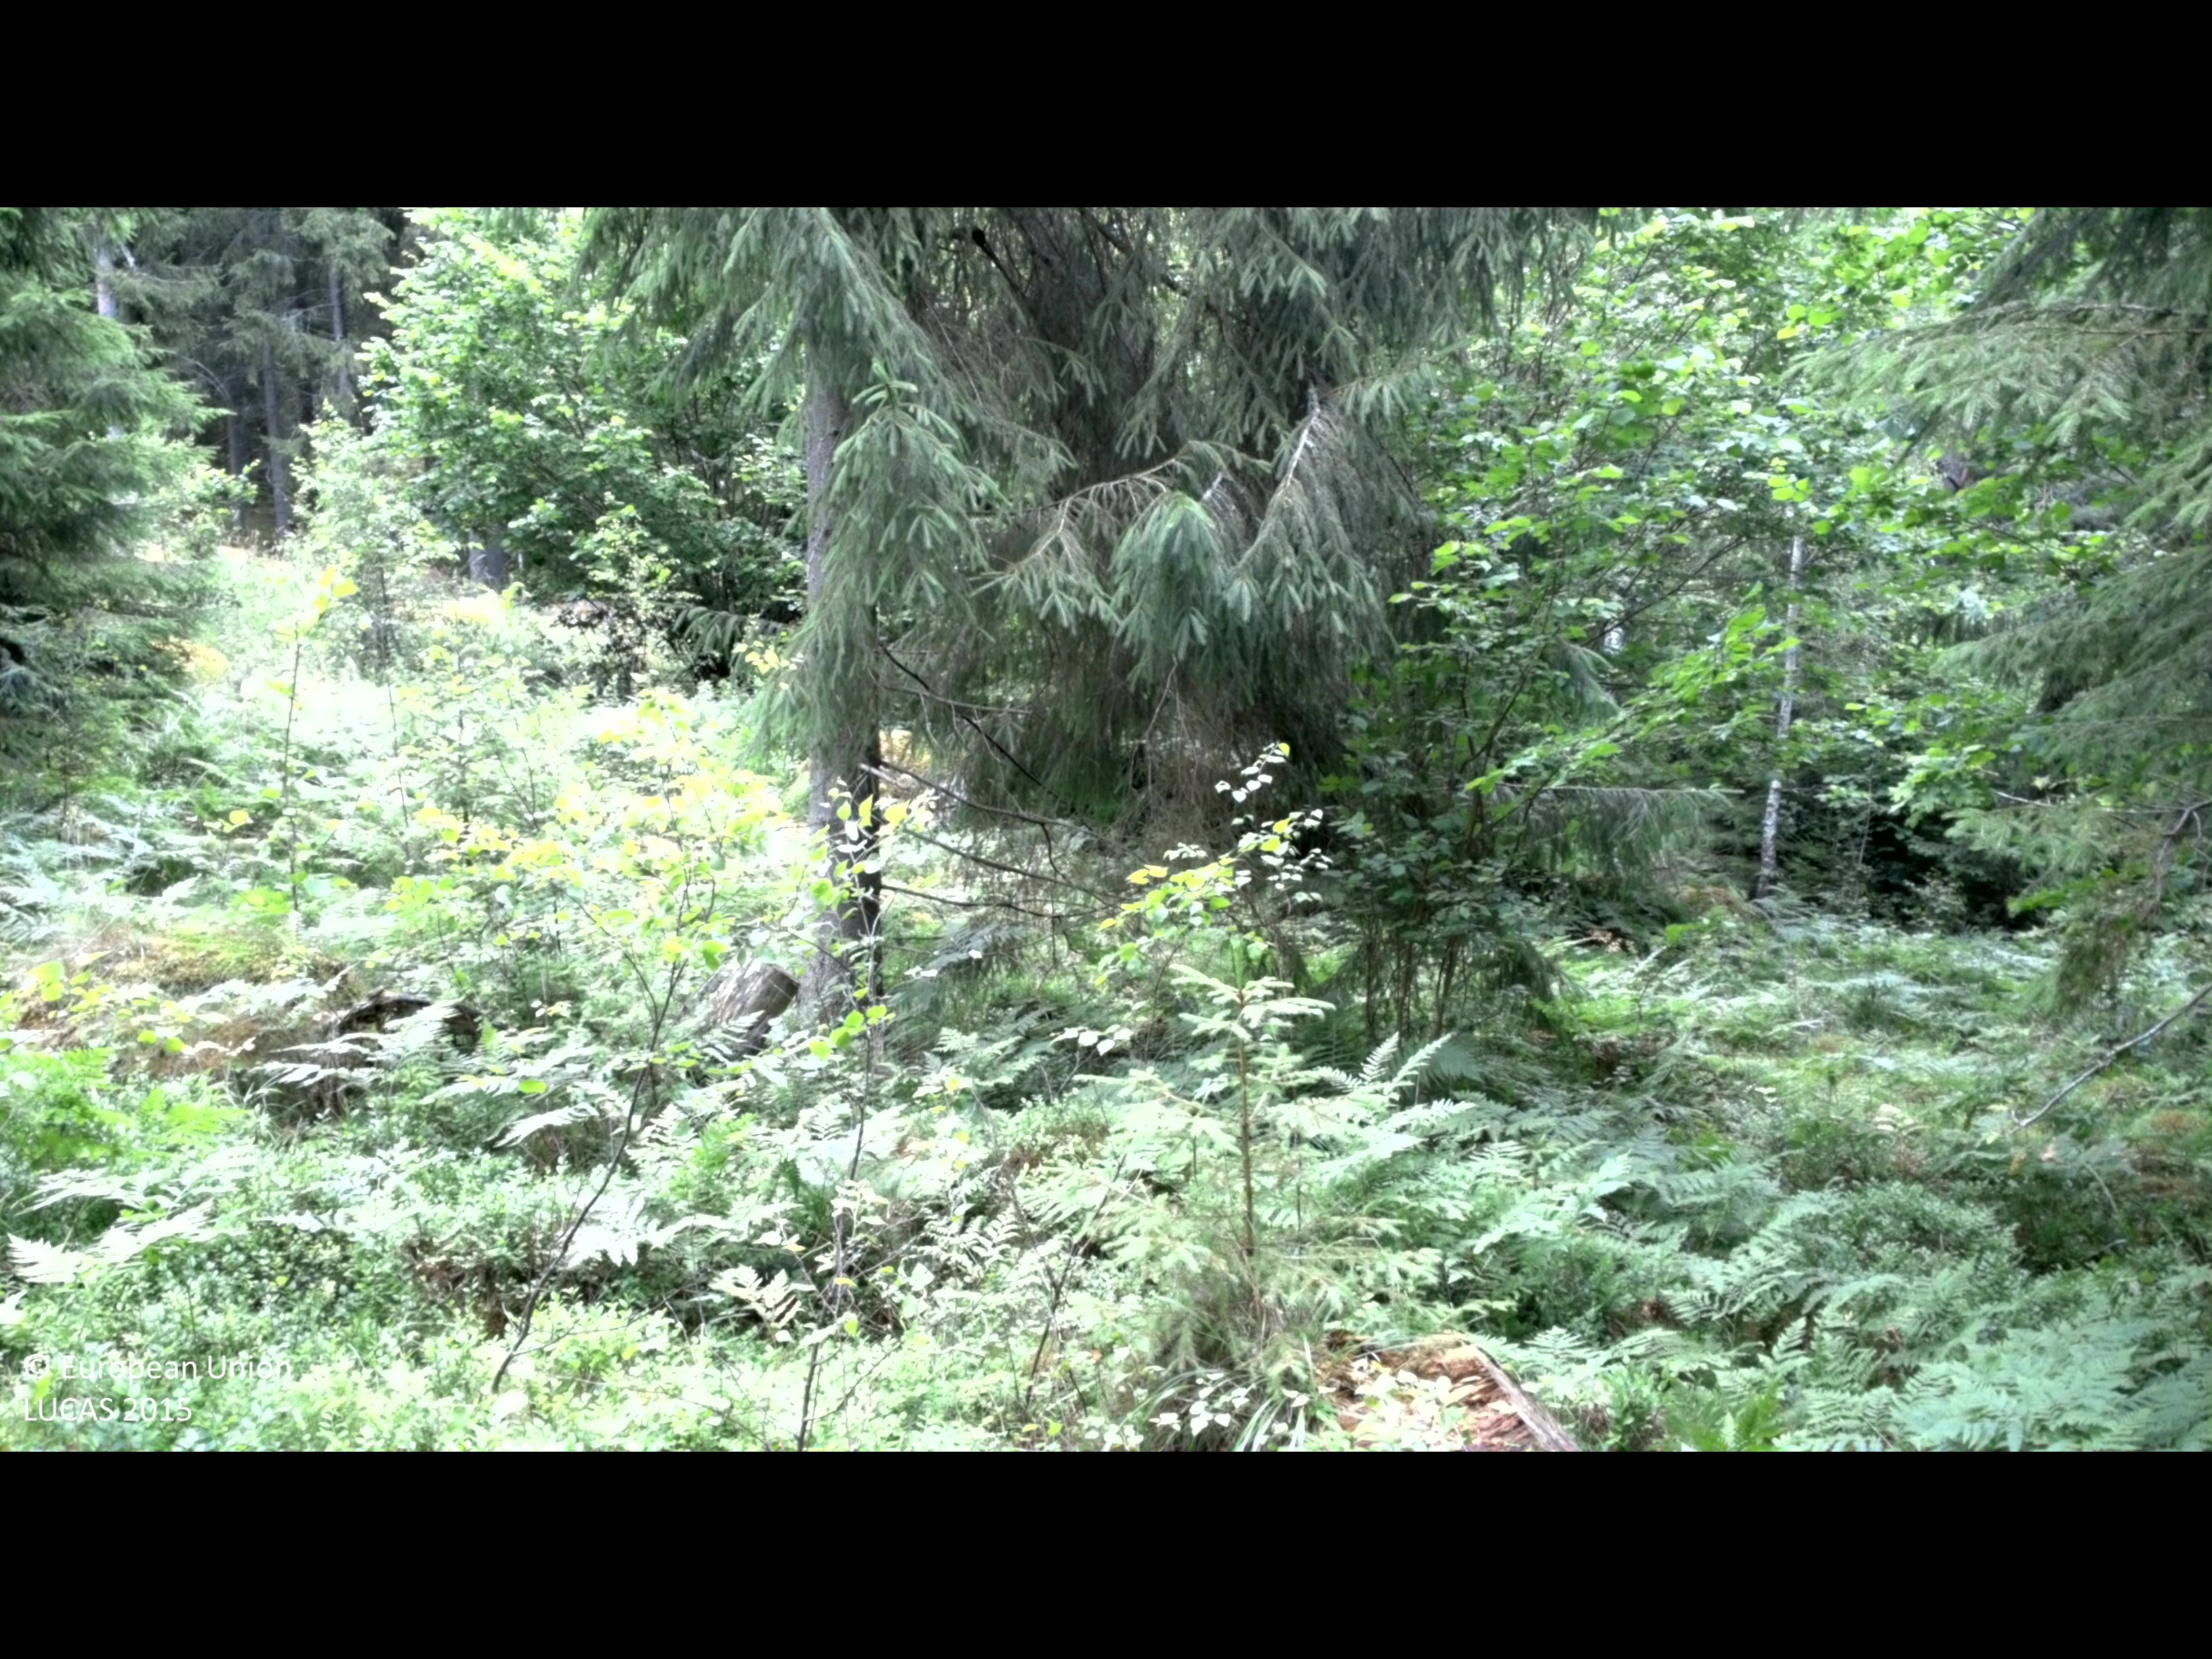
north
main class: Woodland
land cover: Spruce dominated coniferous woodland
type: boreal forest
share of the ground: 50 - 75 %
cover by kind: coniferous forest trees 55 %, shrubs 25 %, herbaceous plants 10 %, broadleaved forest trees 5 %, lichens and mosses 5 %
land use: Forestry
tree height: > 5 m
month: July
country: SE
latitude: 58.1277
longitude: 16.2622
